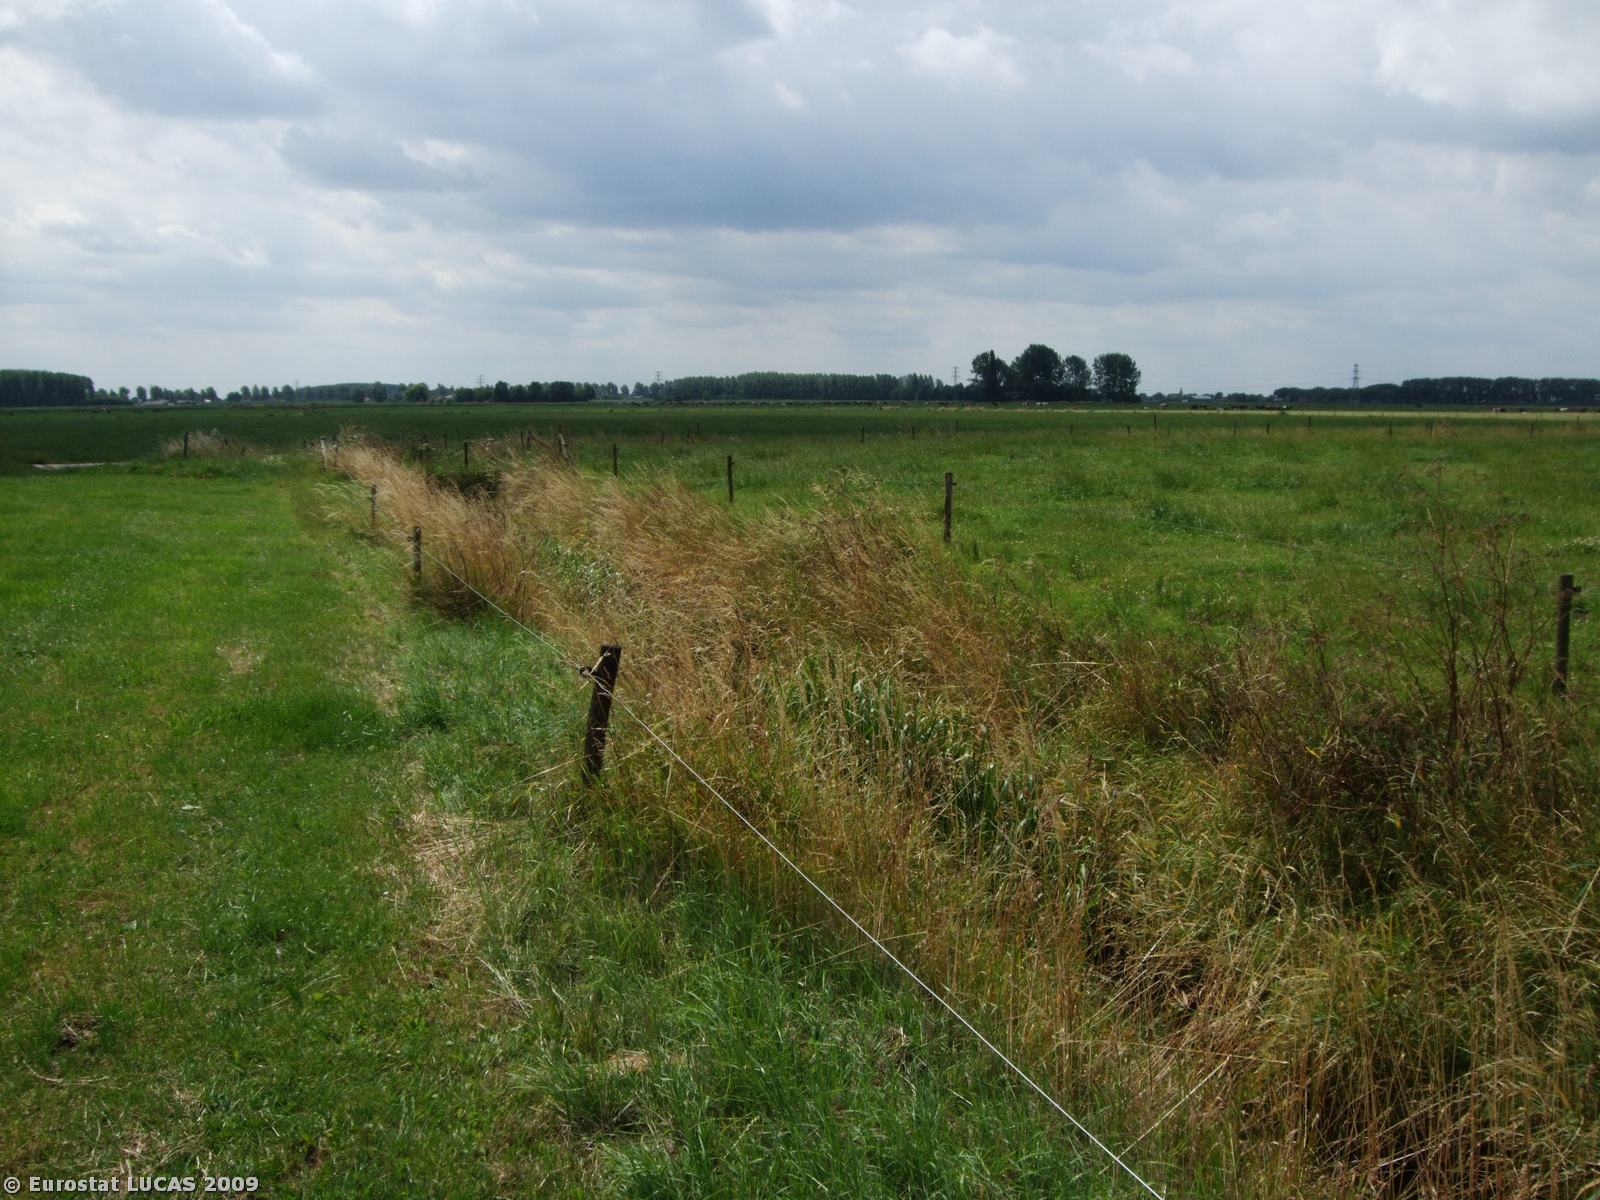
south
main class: Grassland
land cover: Grassland without tree/shrub cover
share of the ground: > 75 %
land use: Agriculture (excluding fallow land and kitchen gardens)
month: July
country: NL
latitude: 51.9267
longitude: 5.3591
